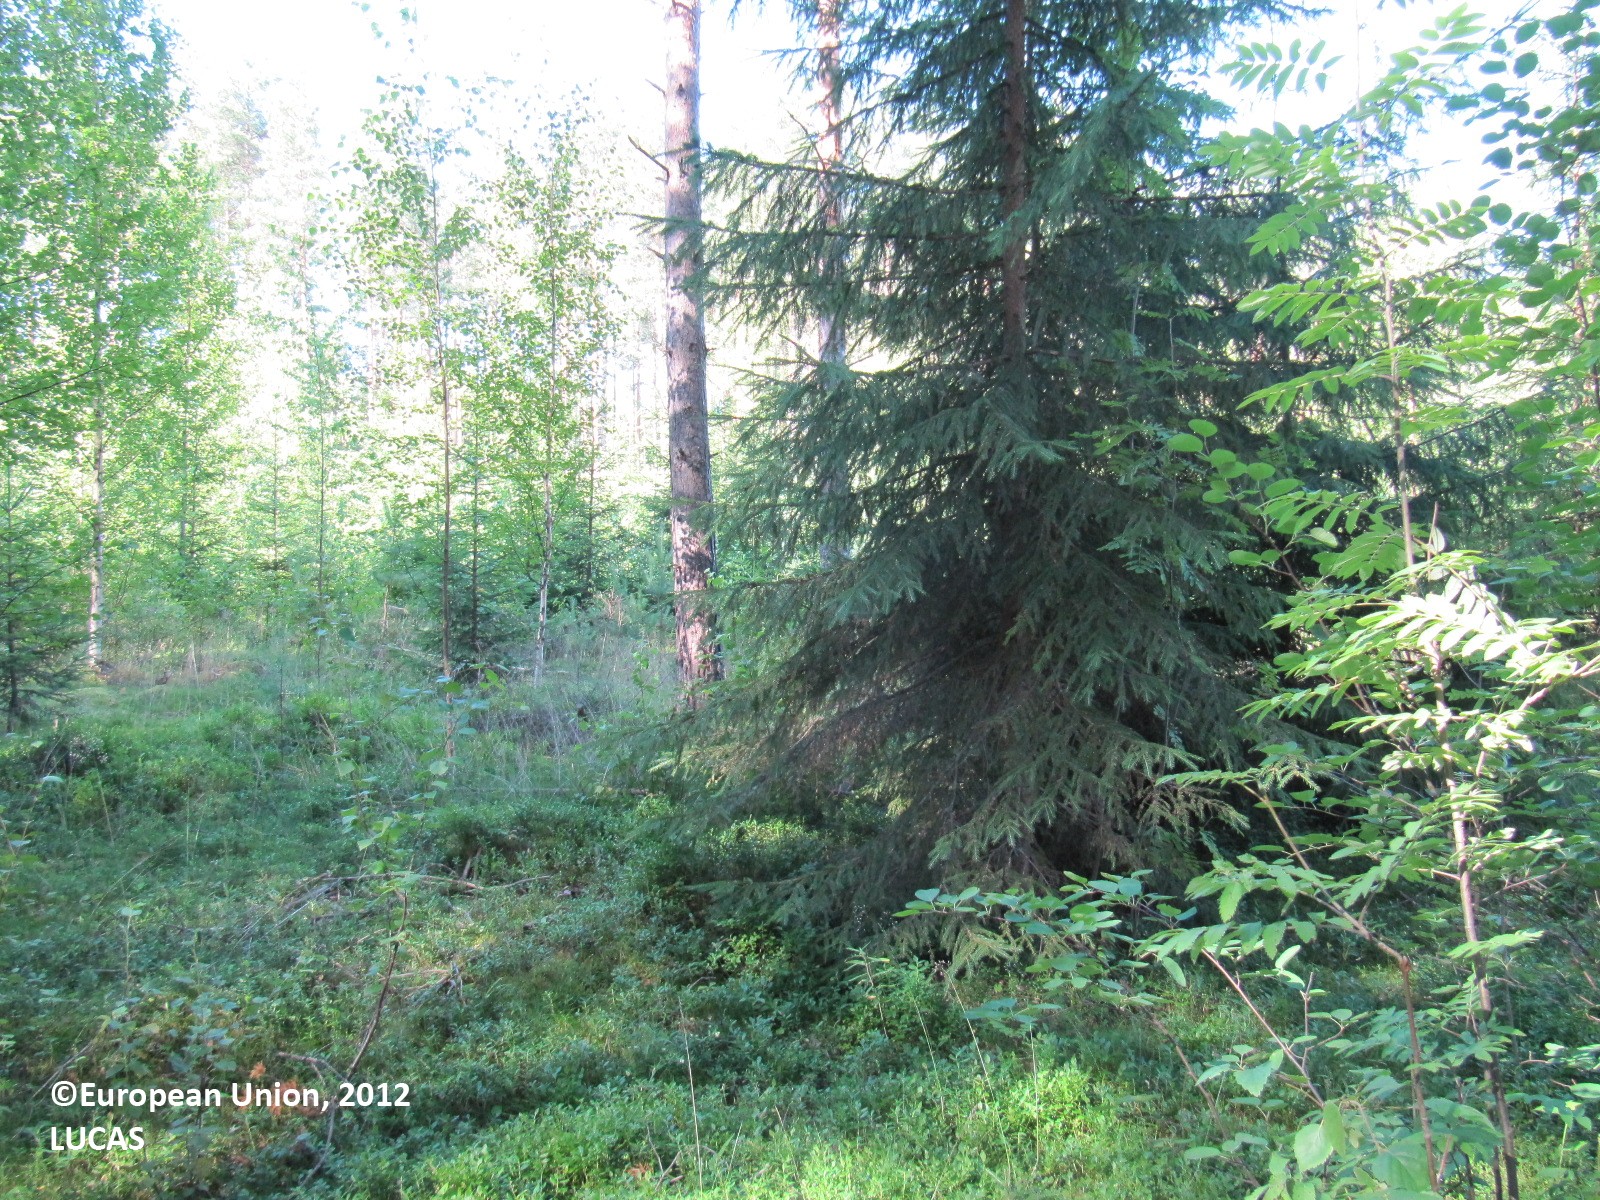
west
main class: Woodland
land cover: Pine dominated mixed woodland
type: boreal forest
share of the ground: > 75 %
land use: Forestry
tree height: > 5 m
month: July
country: FI
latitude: 60.9048
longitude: 24.5770
